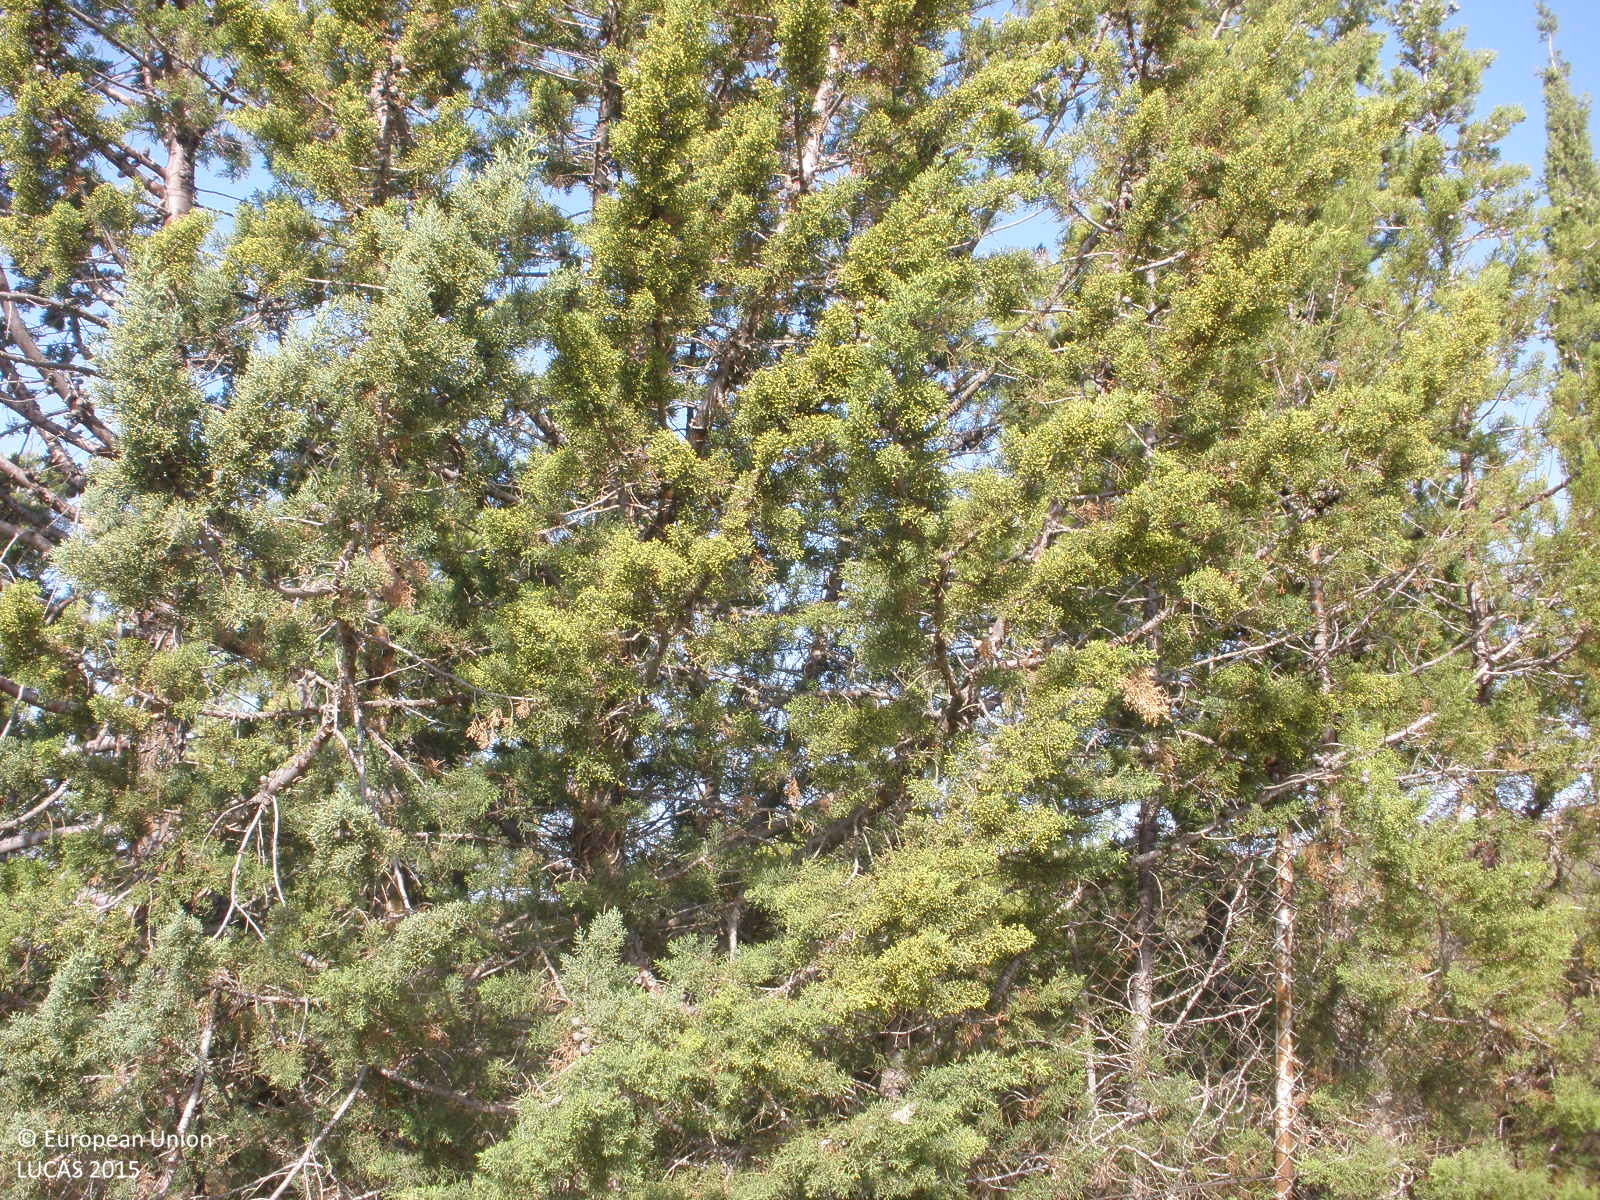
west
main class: Woodland
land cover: Pine dominated coniferous woodland
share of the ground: 50 - 75 %
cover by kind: coniferous forest trees 50 %, shrubs 40 %, consolidated bare surface 10 %
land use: Residential
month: July
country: ES
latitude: 40.2120
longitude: -3.3427
